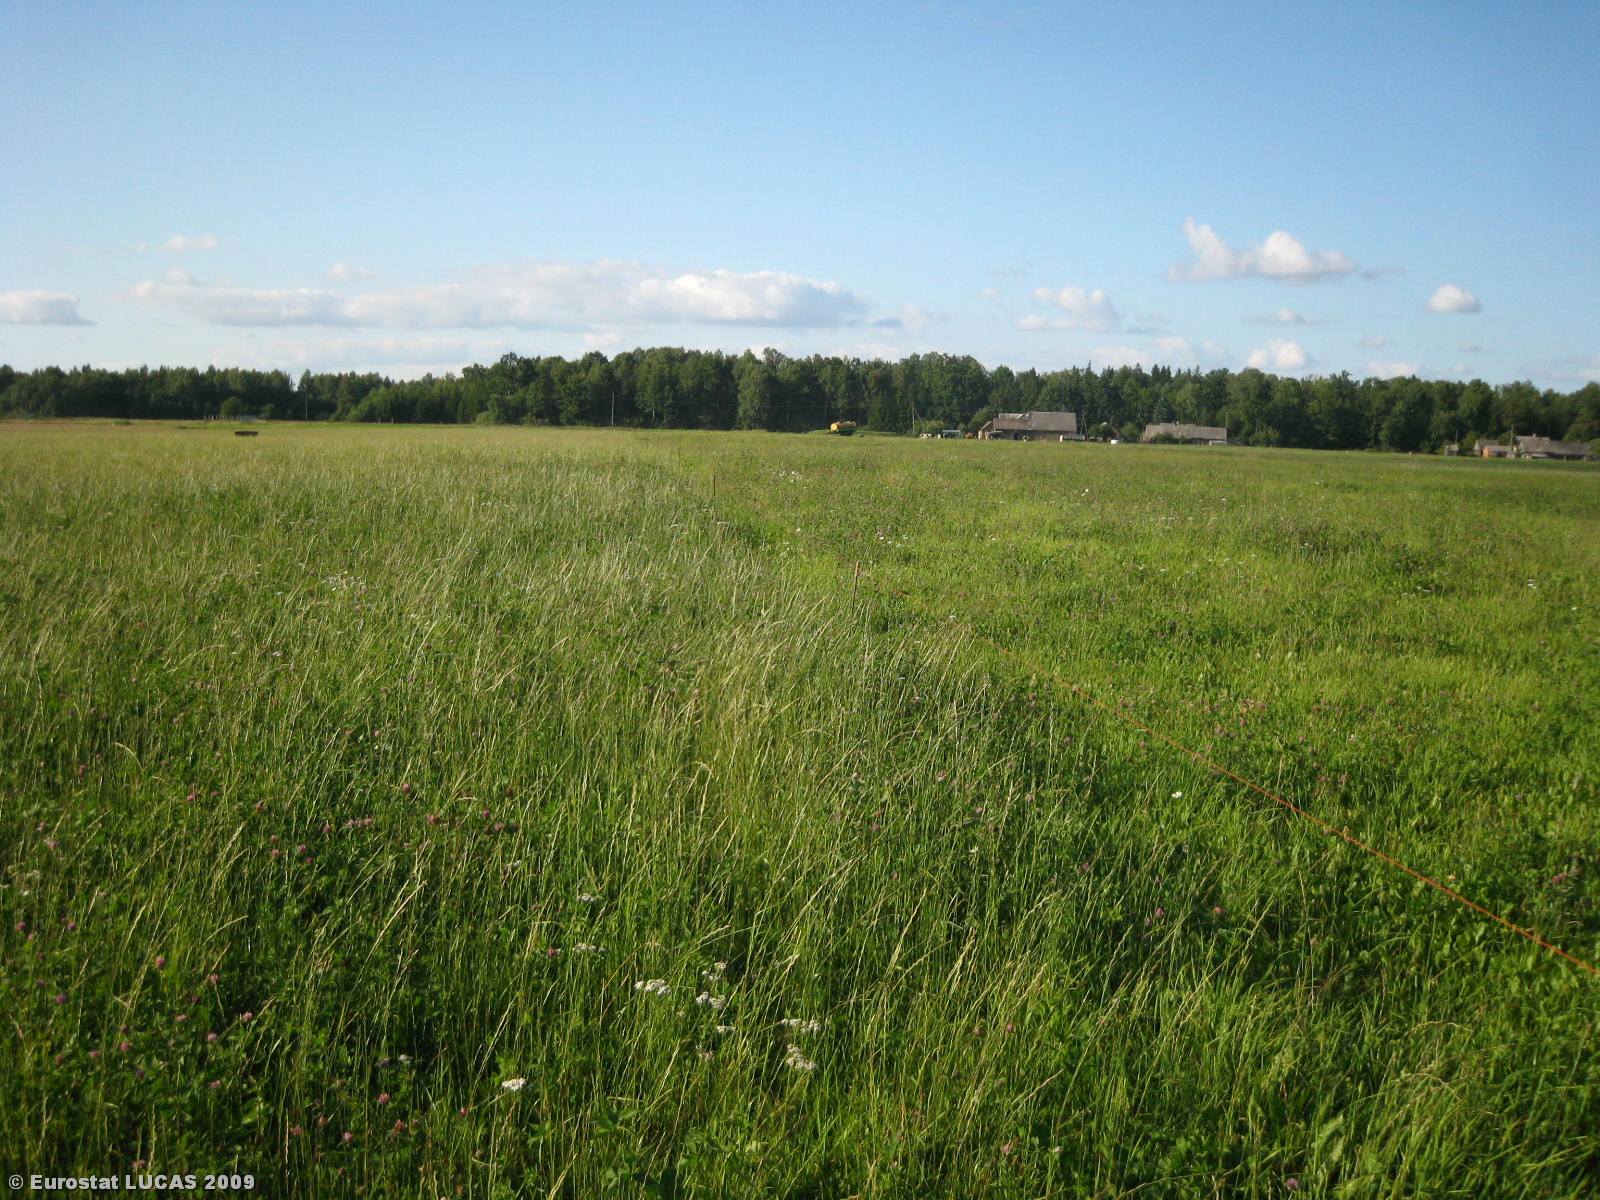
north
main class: Grassland
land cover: Grassland without tree/shrub cover
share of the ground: > 75 %
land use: Agriculture (excluding fallow land and kitchen gardens)
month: July
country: LT
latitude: 55.3505
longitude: 23.7581
